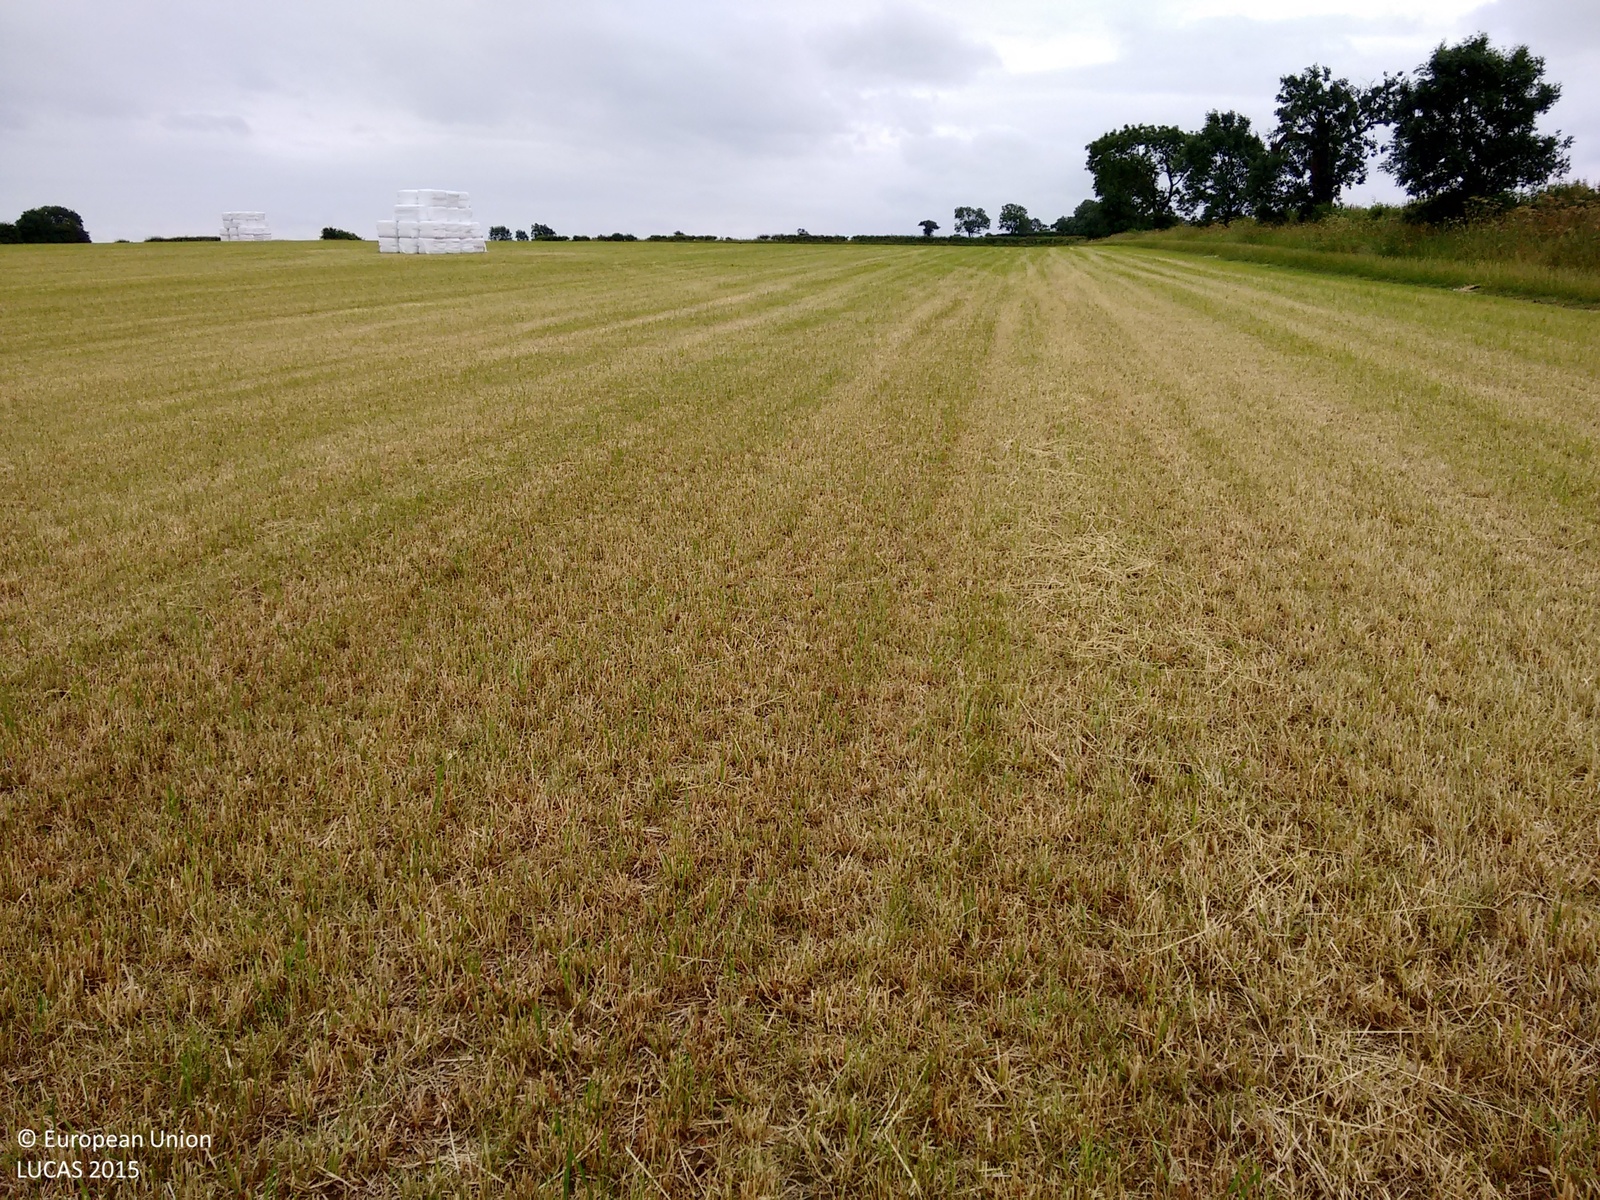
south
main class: Grassland
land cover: Grassland without tree/shrub cover
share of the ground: > 75 %
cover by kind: herbaceous plants 100 %
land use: Agriculture (excluding fallow land and kitchen gardens)
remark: Harvested field
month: July
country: GB
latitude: 52.8255
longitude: -1.0115
